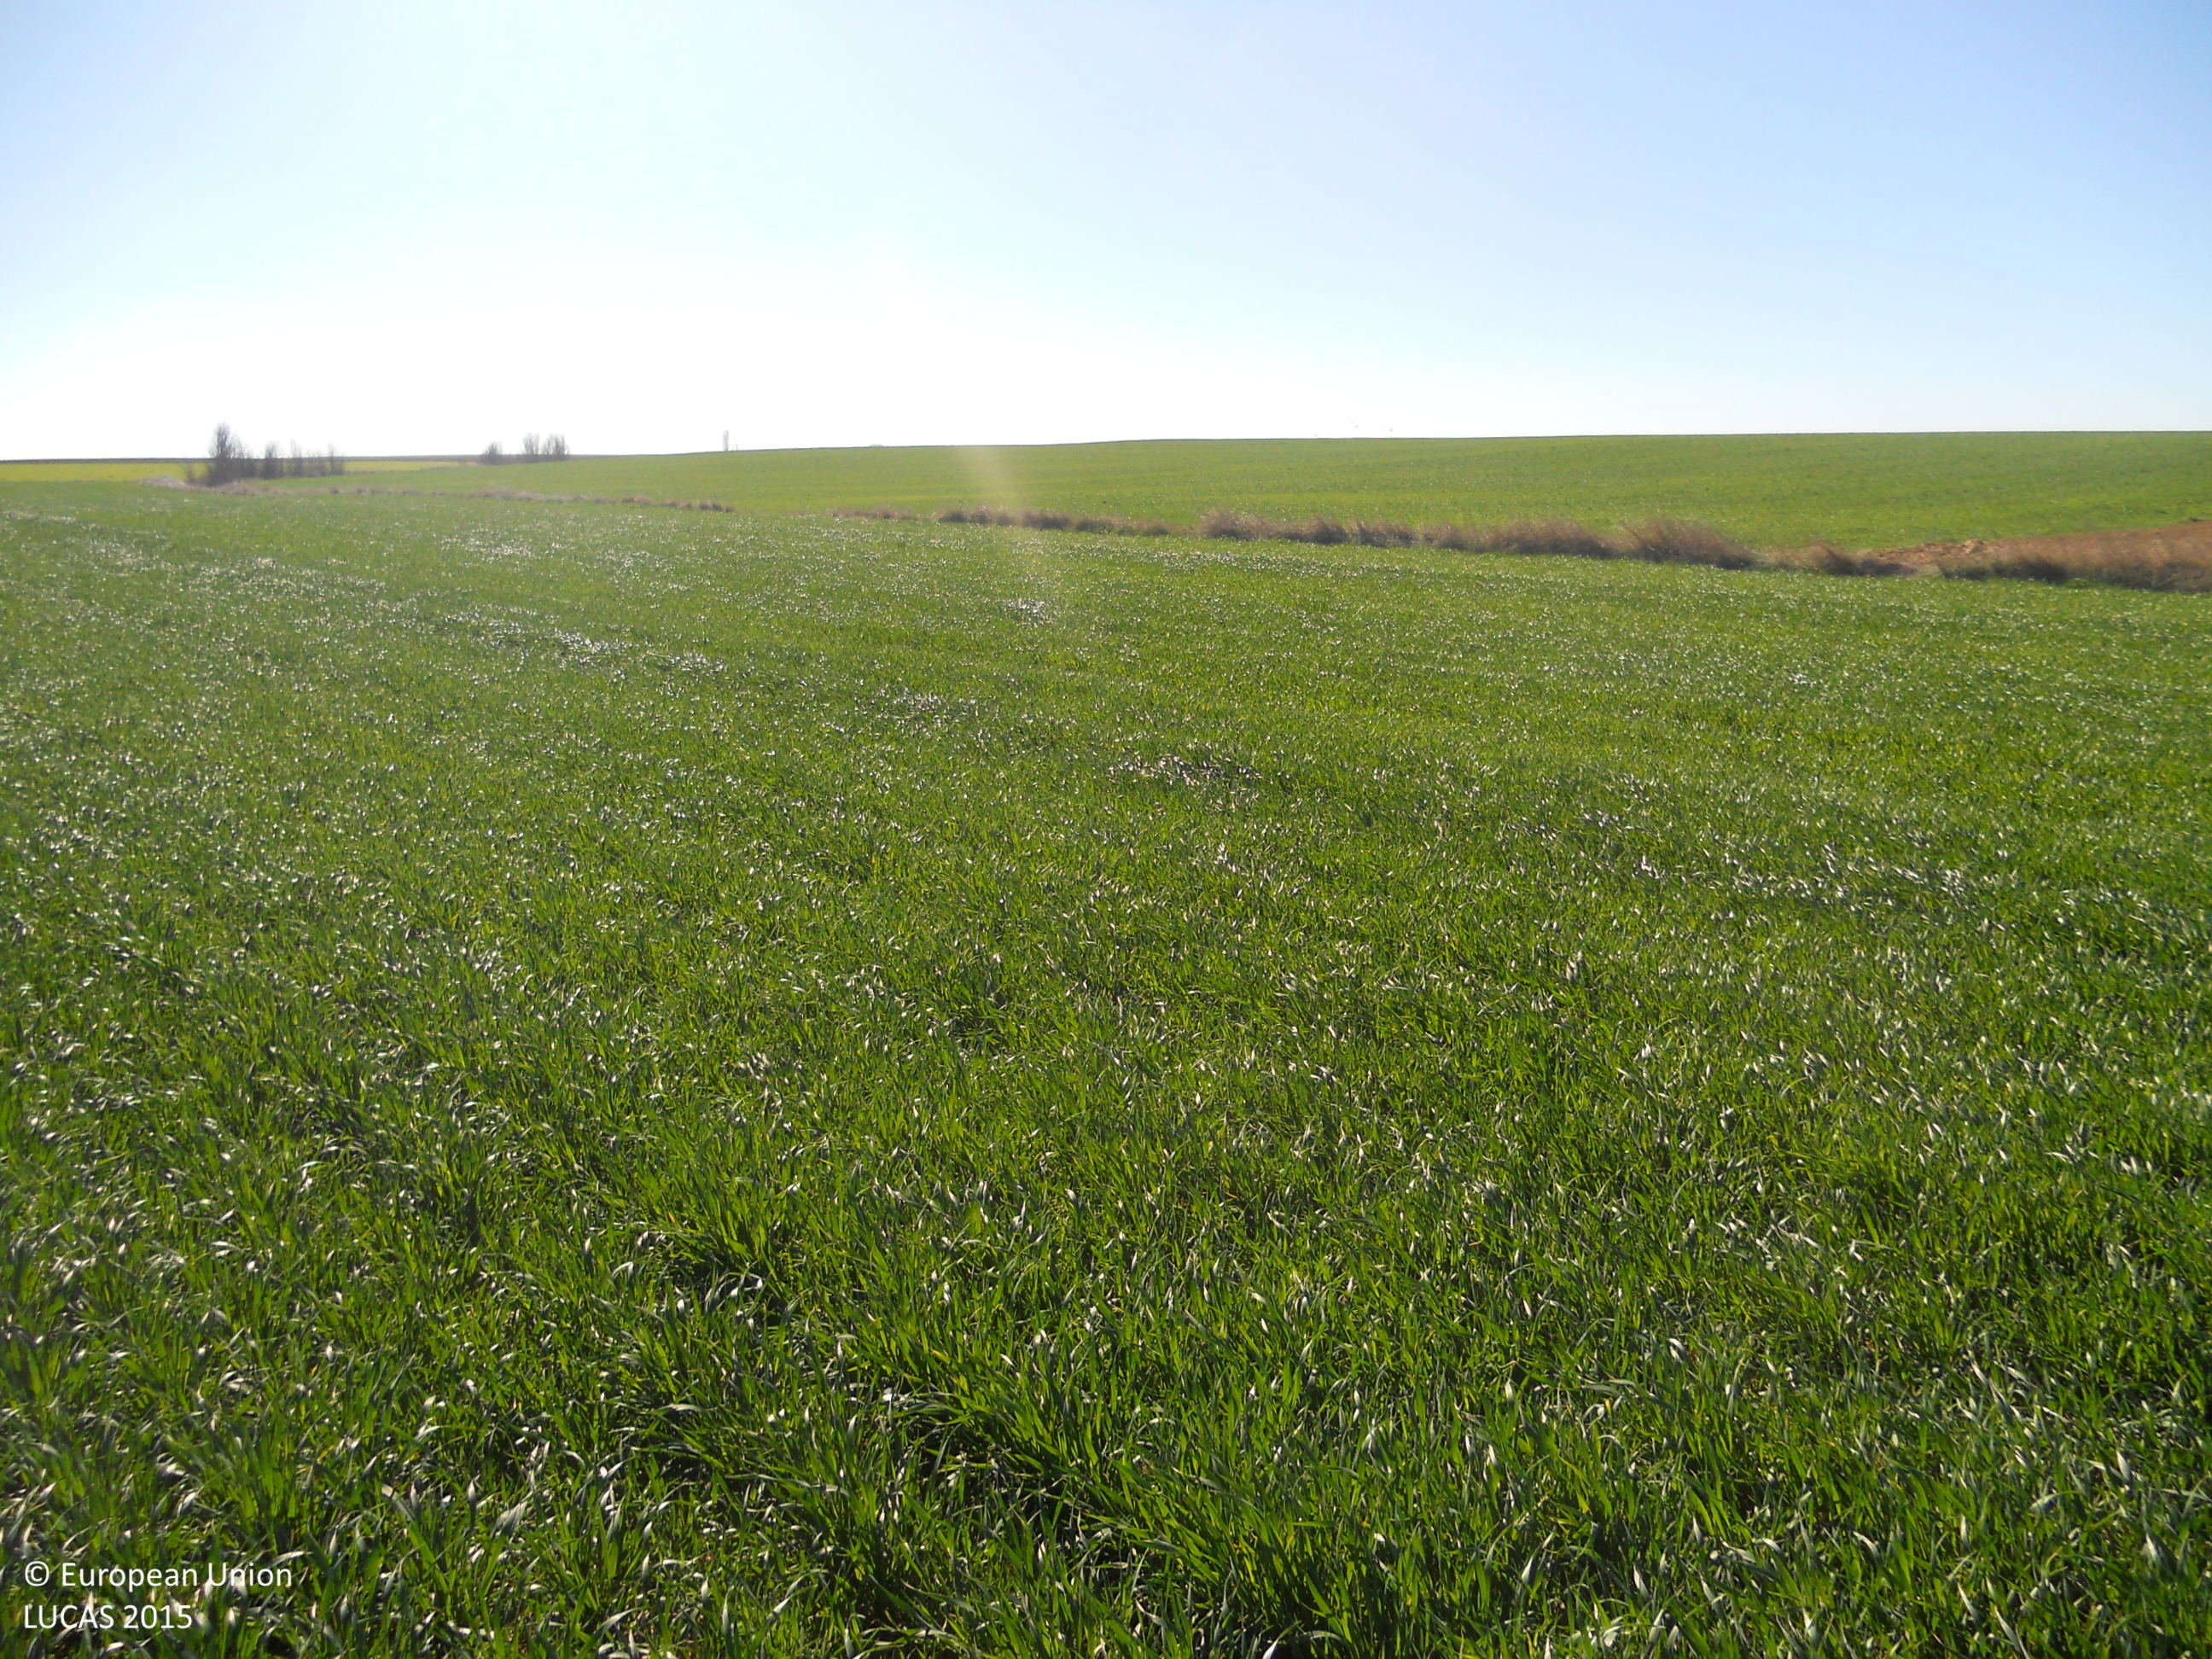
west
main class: Cropland
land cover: Common wheat
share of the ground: > 75 %
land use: Agriculture (excluding fallow land and kitchen gardens)
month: April
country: ES
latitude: 42.3040
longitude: -4.3484
